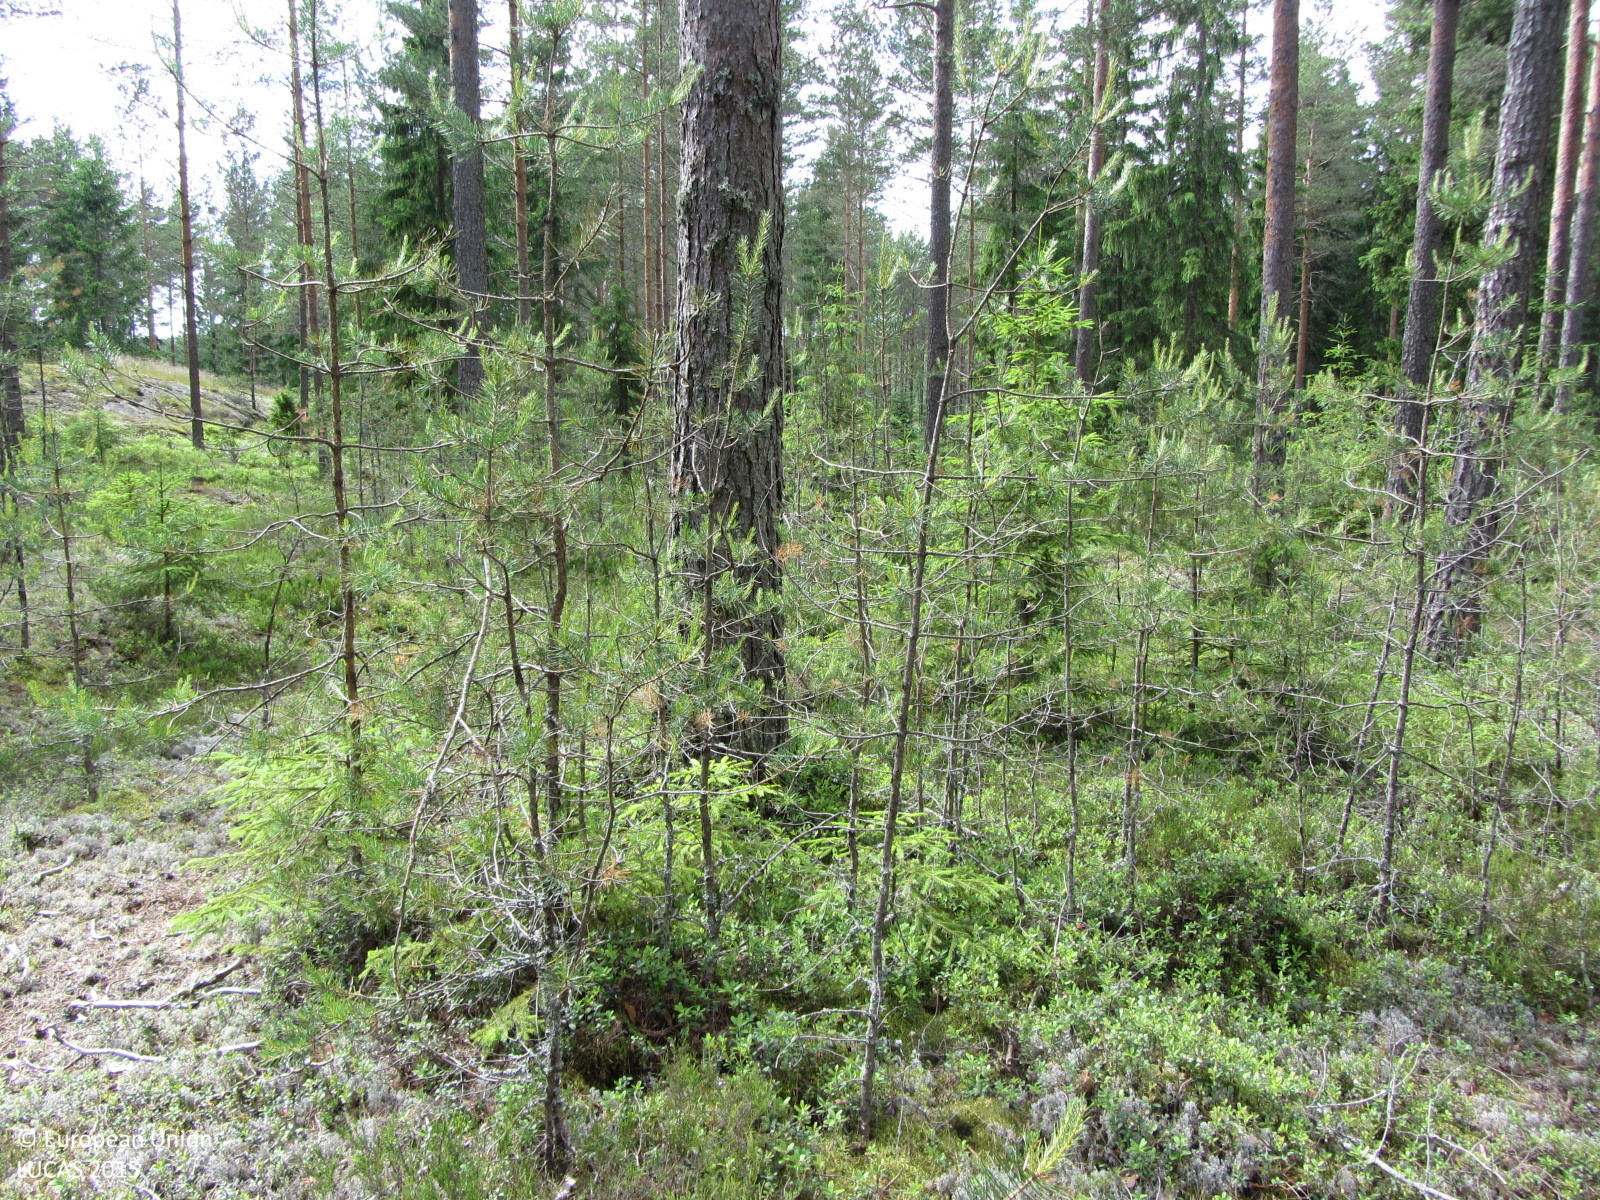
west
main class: Woodland
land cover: Other coniferous woodland
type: boreal forest
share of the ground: > 75 %
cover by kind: coniferous forest trees 75 %, shrubs 15 %, lichens and mosses 10 %
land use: Forestry
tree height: > 5 m
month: June
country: FI
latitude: 60.1057
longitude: 23.1969
